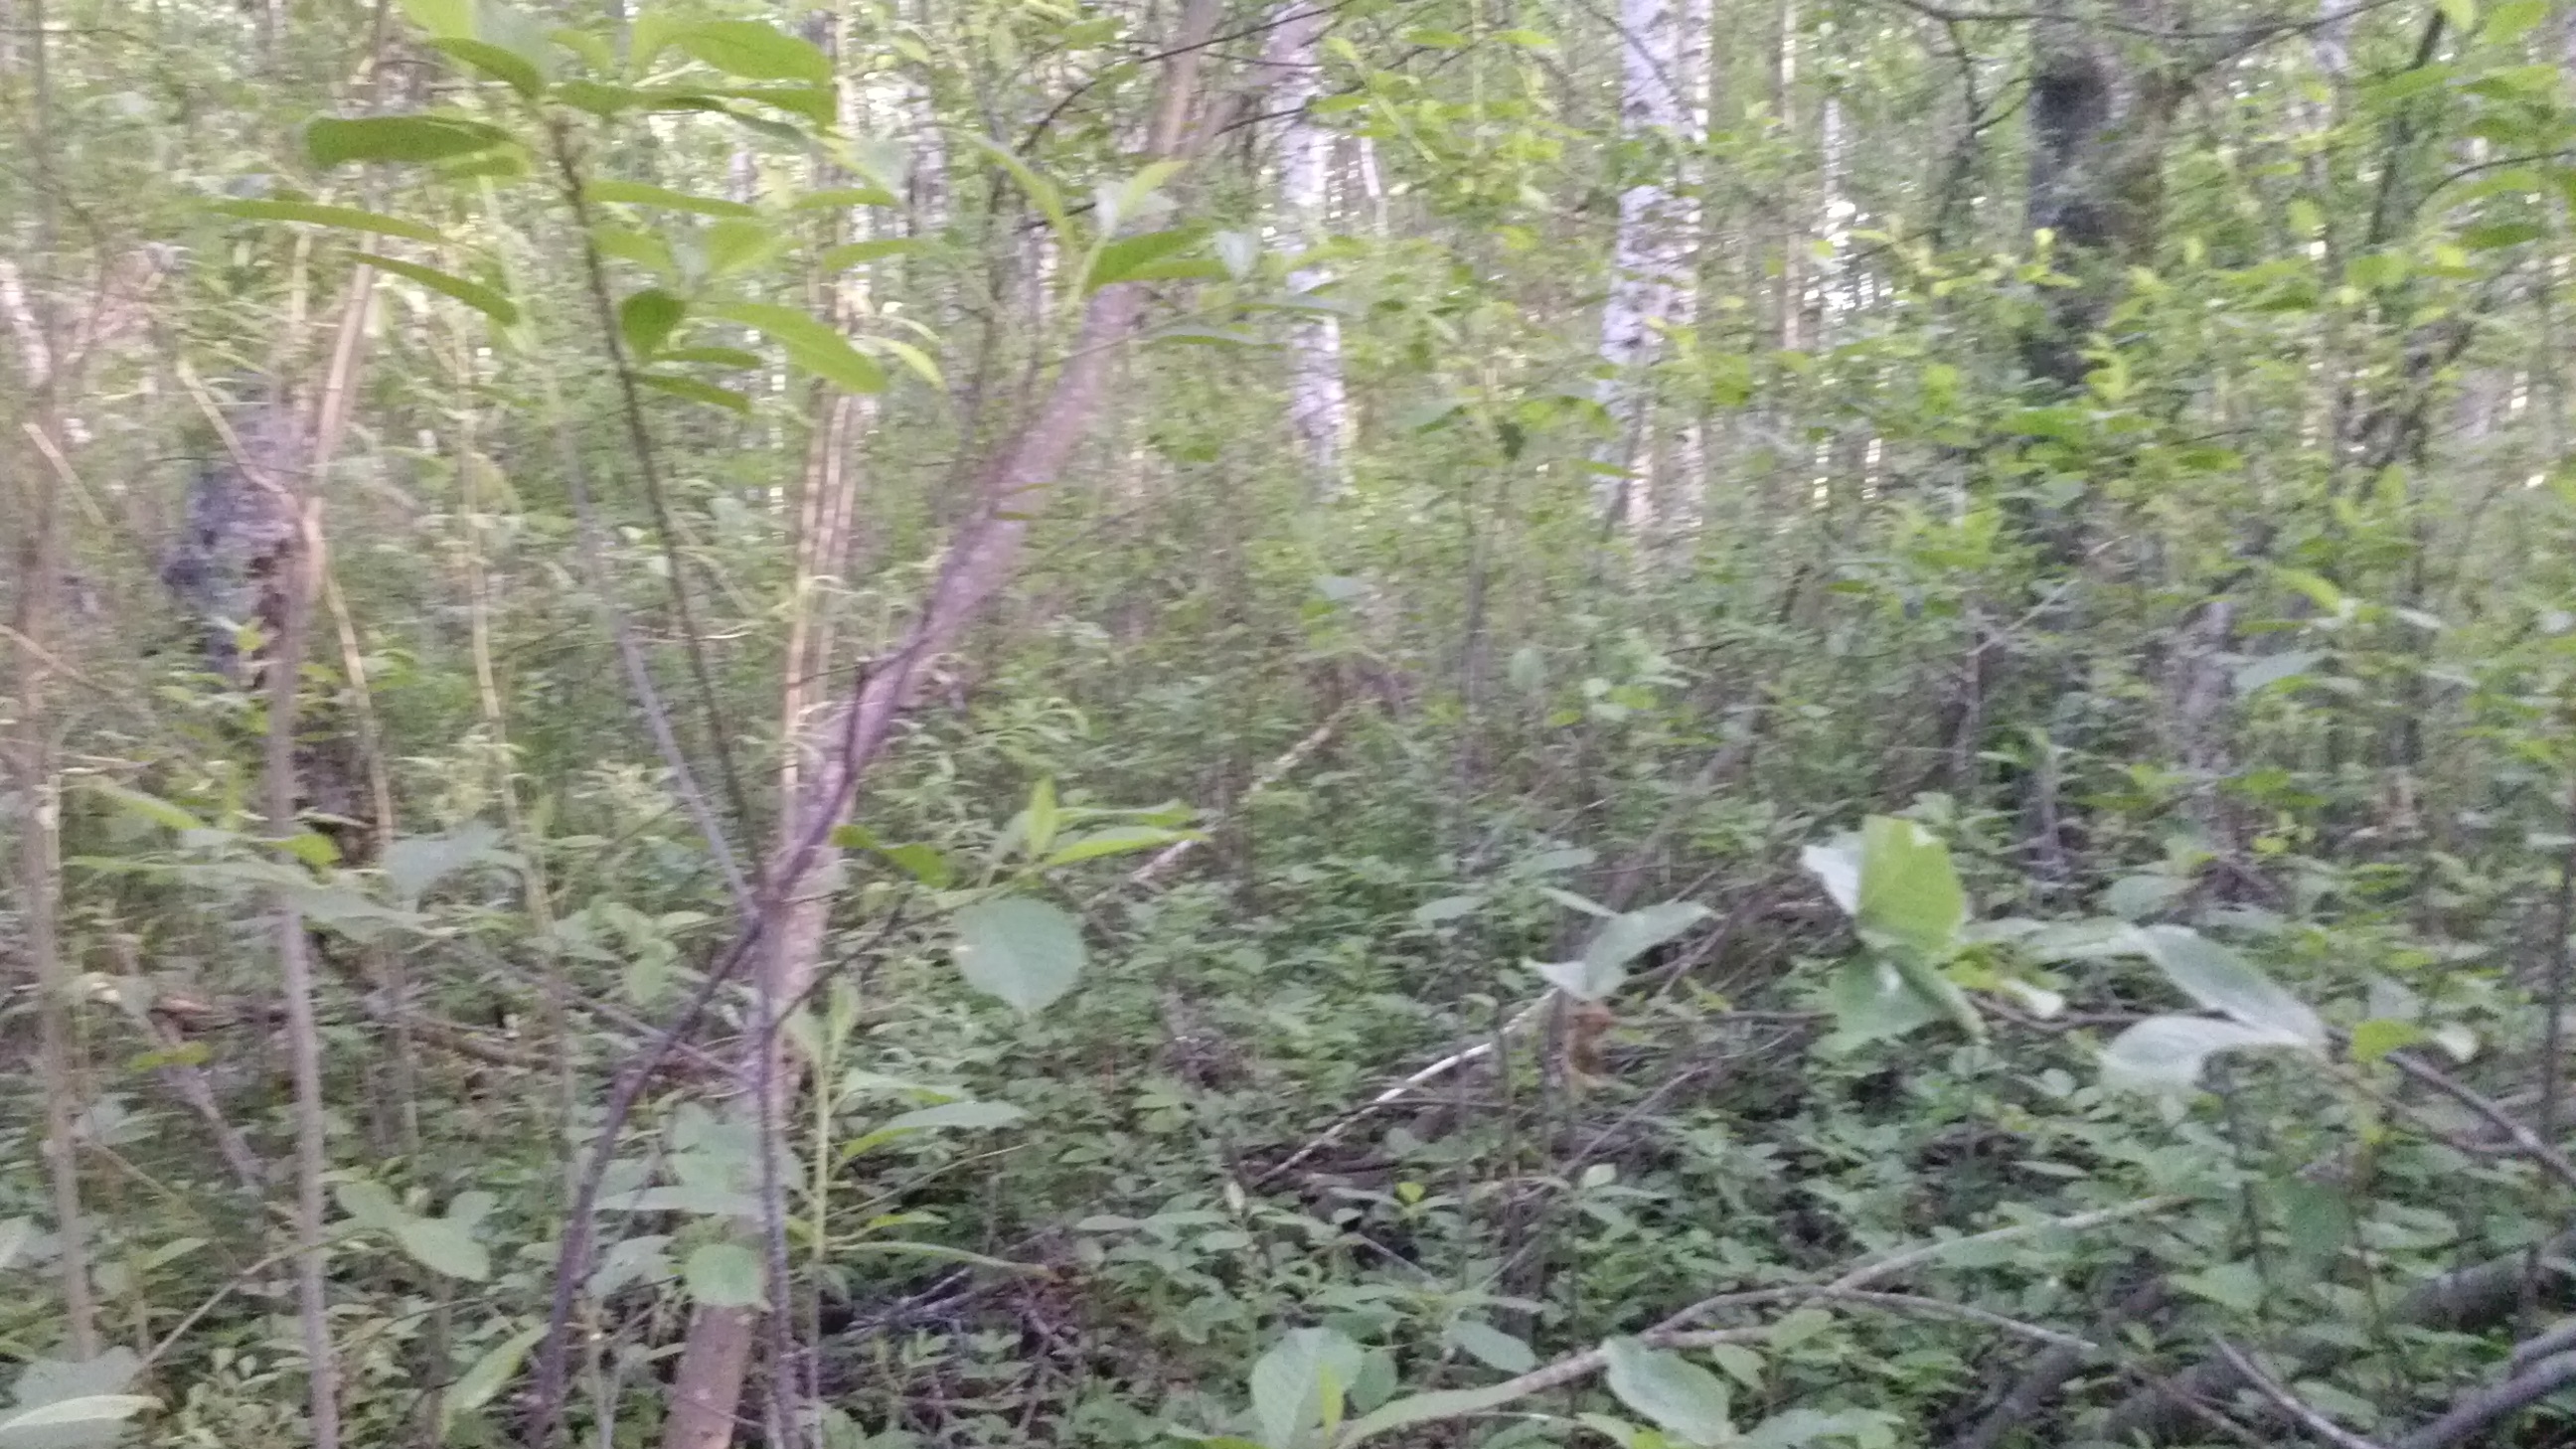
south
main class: Woodland
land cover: Broadleaved woodland
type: non-riverine alder, birch or aspen forest
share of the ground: > 75 %
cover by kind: broadleaved forest trees 95 %, herbaceous plants 5 %
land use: Forestry
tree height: > 5 m
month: June
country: LV
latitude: 56.4088
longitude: 27.9073
